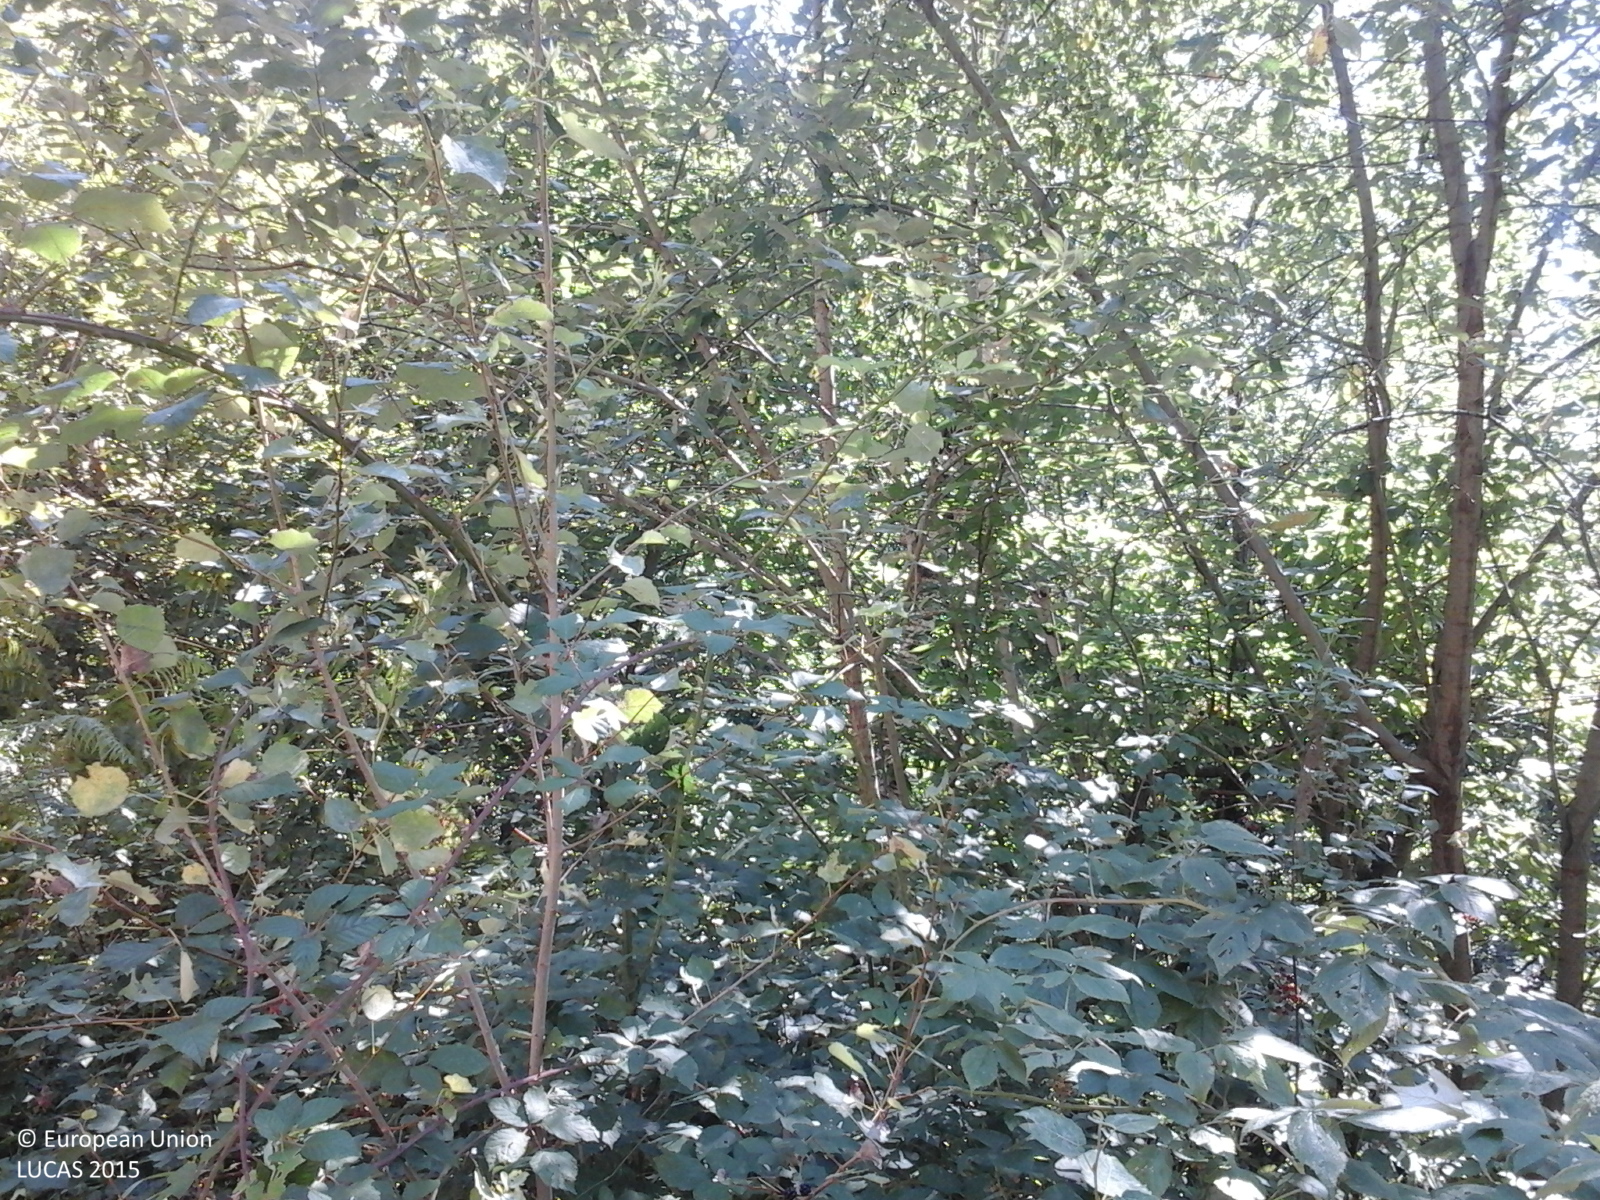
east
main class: Woodland
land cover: Broadleaved woodland
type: beech forest
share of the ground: > 75 %
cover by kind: broadleaved forest trees 100 %
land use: Forestry
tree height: > 5 m
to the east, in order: Broadleaved woodland; Paved roads, cycling and walking lanes; Broadleaved woodland; Paved roads, cycling and walking lanes; Broadleaved woodland; Paved roads, cycling and walking lanes; Broadleaved woodland
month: September
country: RO
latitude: 46.6817
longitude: 22.5651
